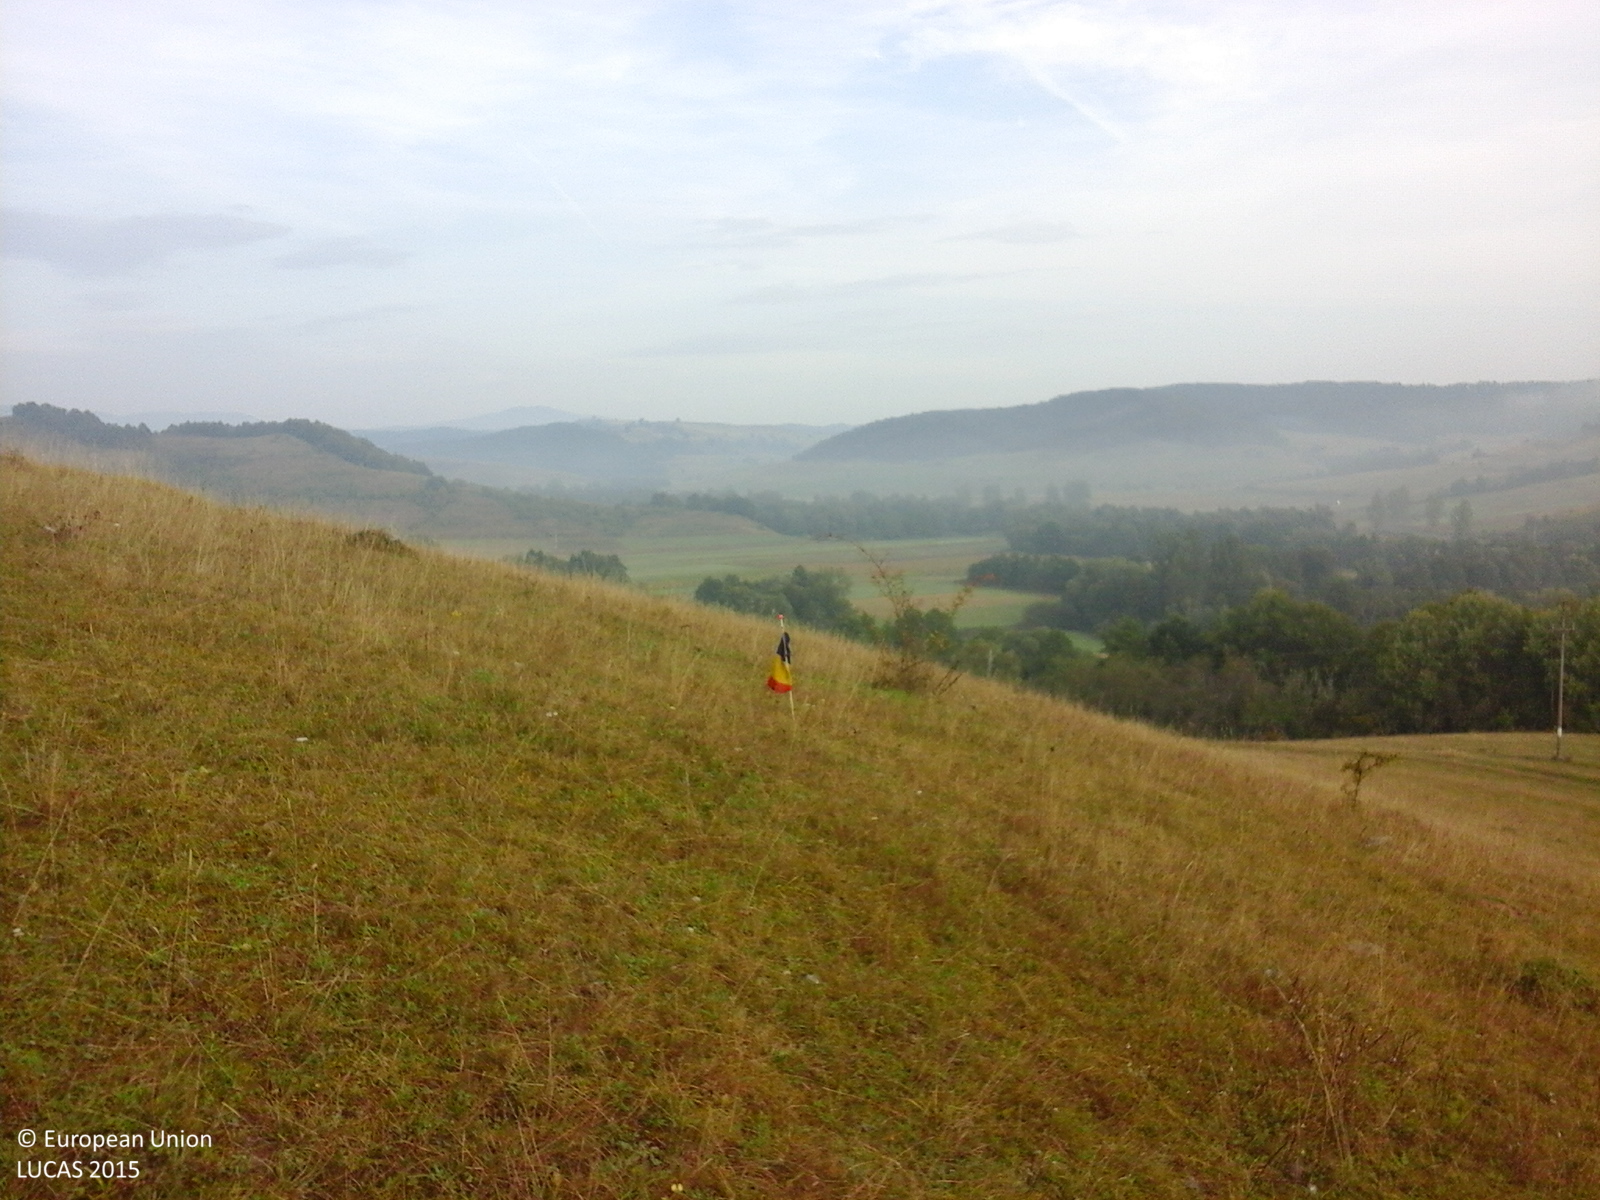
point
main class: Grassland
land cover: Grassland without tree/shrub cover
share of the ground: > 75 %
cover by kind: herbaceous plants 100 %
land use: Agriculture (excluding fallow land and kitchen gardens)
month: September
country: RO
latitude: 46.9153
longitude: 23.0485
